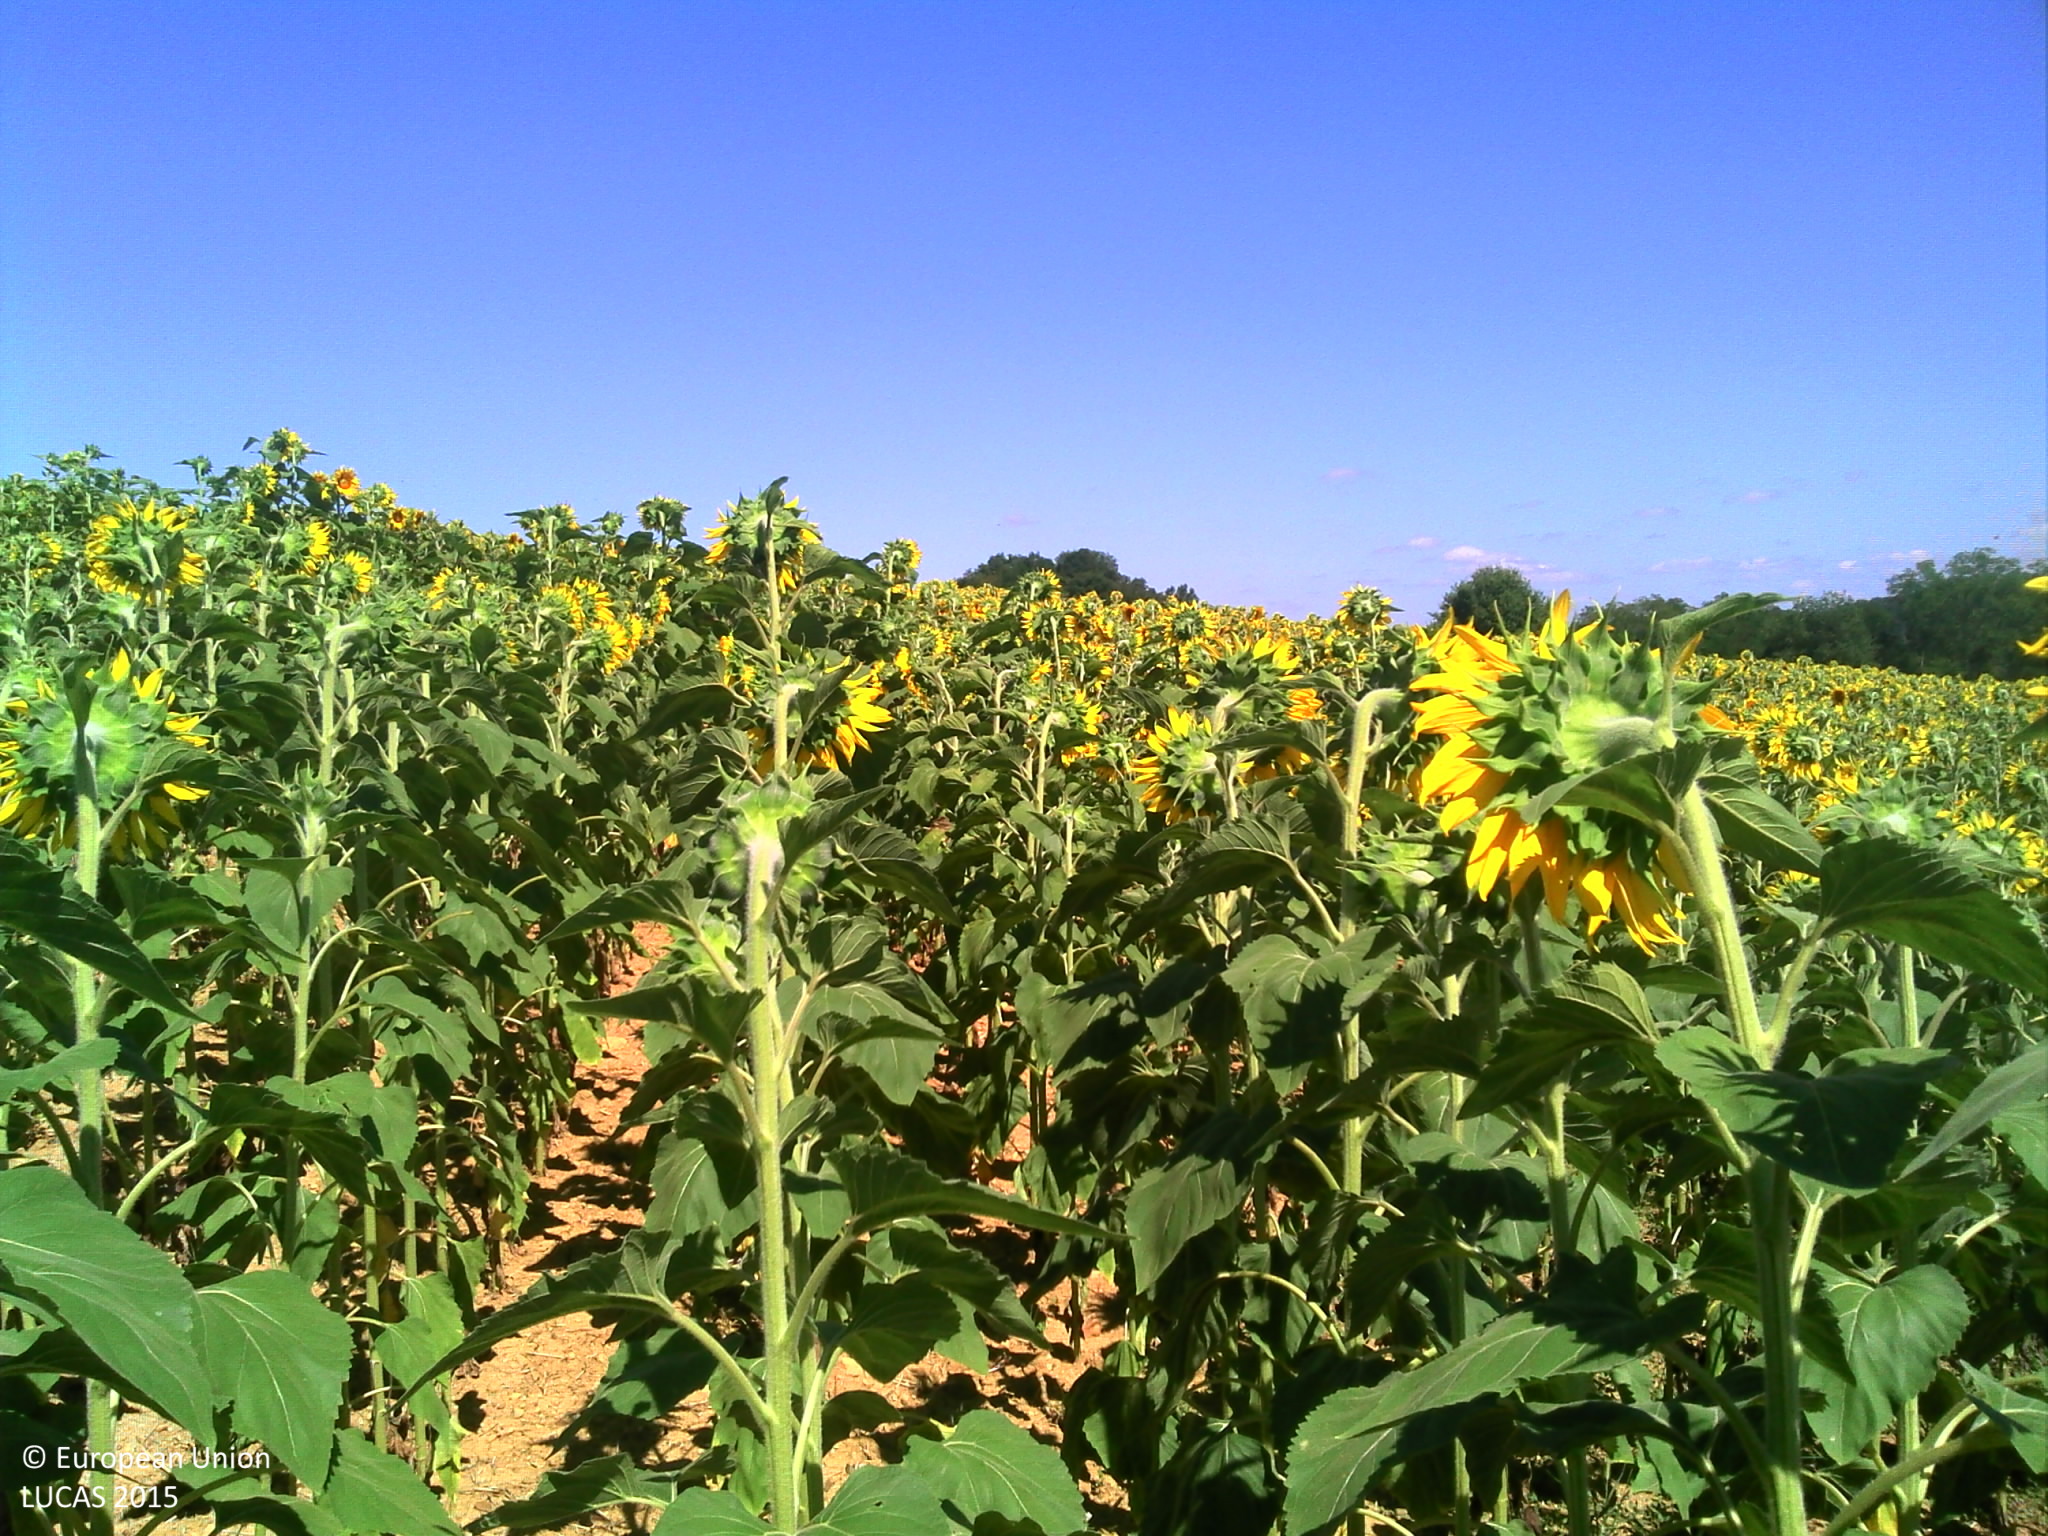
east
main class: Cropland
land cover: Sunflower
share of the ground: > 75 %
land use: Agriculture (excluding fallow land and kitchen gardens)
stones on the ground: < 10 %
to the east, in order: Sunflower; Grassland without tree/shrub cover; Spontaneously vegetated surfaces; Broadleaved woodland; Grassland without tree/shrub cover; Broadleaved woodland
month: July
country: FR
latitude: 43.2113
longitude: 0.7573
